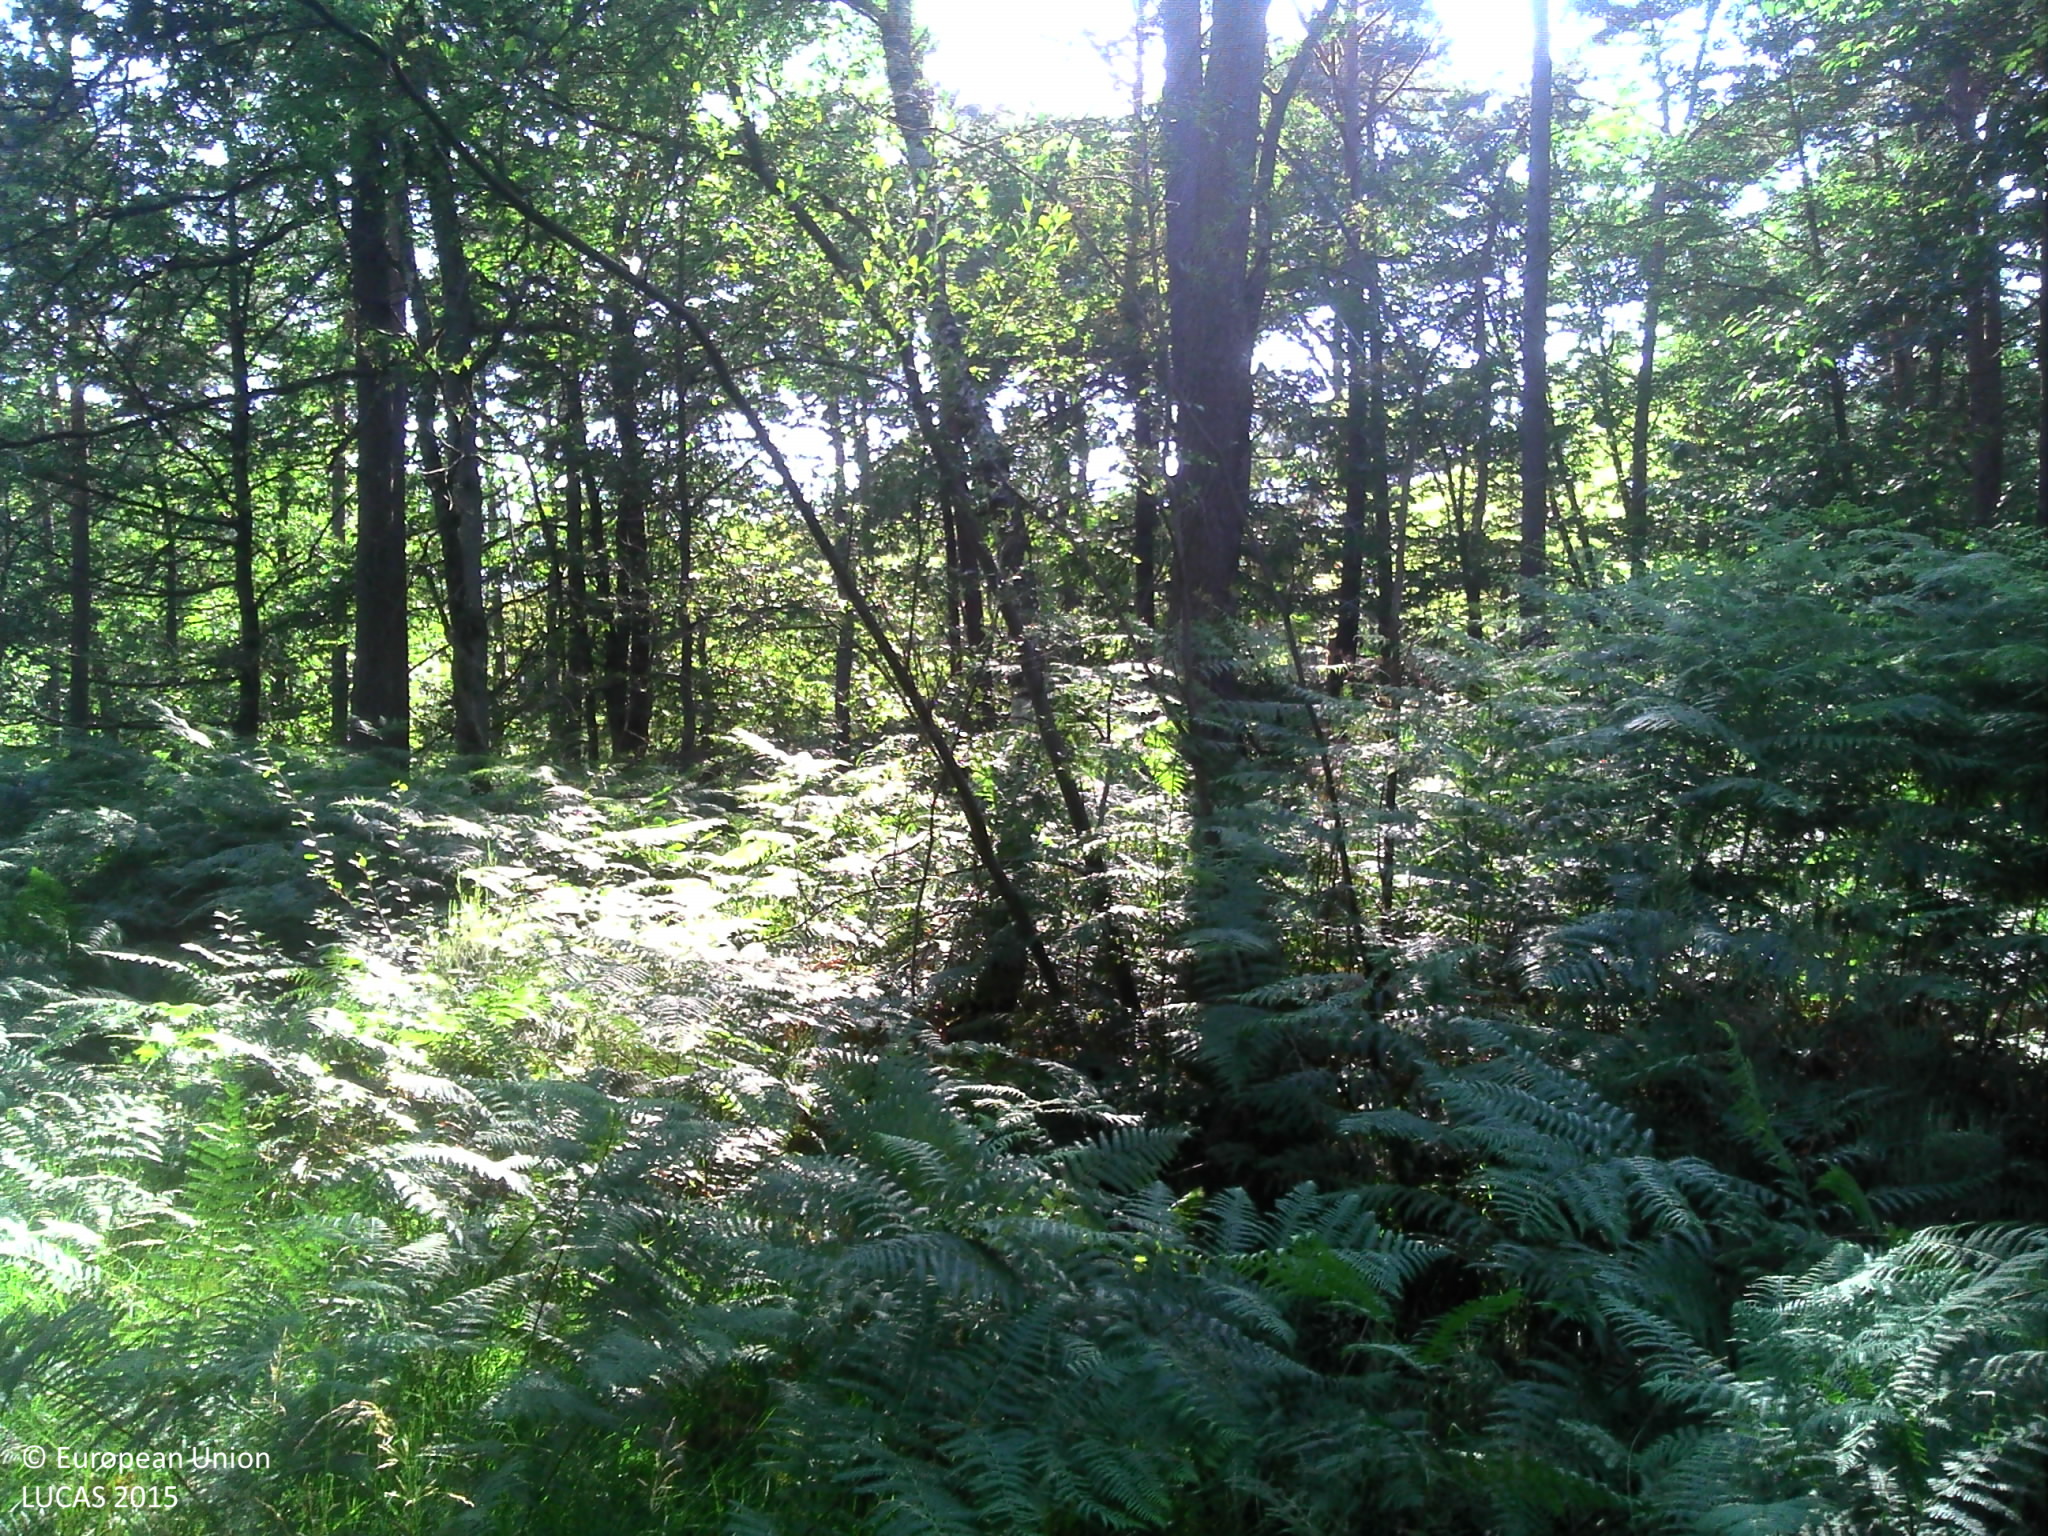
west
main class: Woodland
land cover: Pine dominated mixed woodland
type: mesophytic deciduous forest
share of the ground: > 75 %
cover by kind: coniferous forest trees 35 %, broadleaved forest trees 35 %, herbaceous plants 15 %, shrubs 10 %, lichens and mosses 5 %
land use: Forestry
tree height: > 5 m
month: July
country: FR
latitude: 47.2350
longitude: 0.3222
